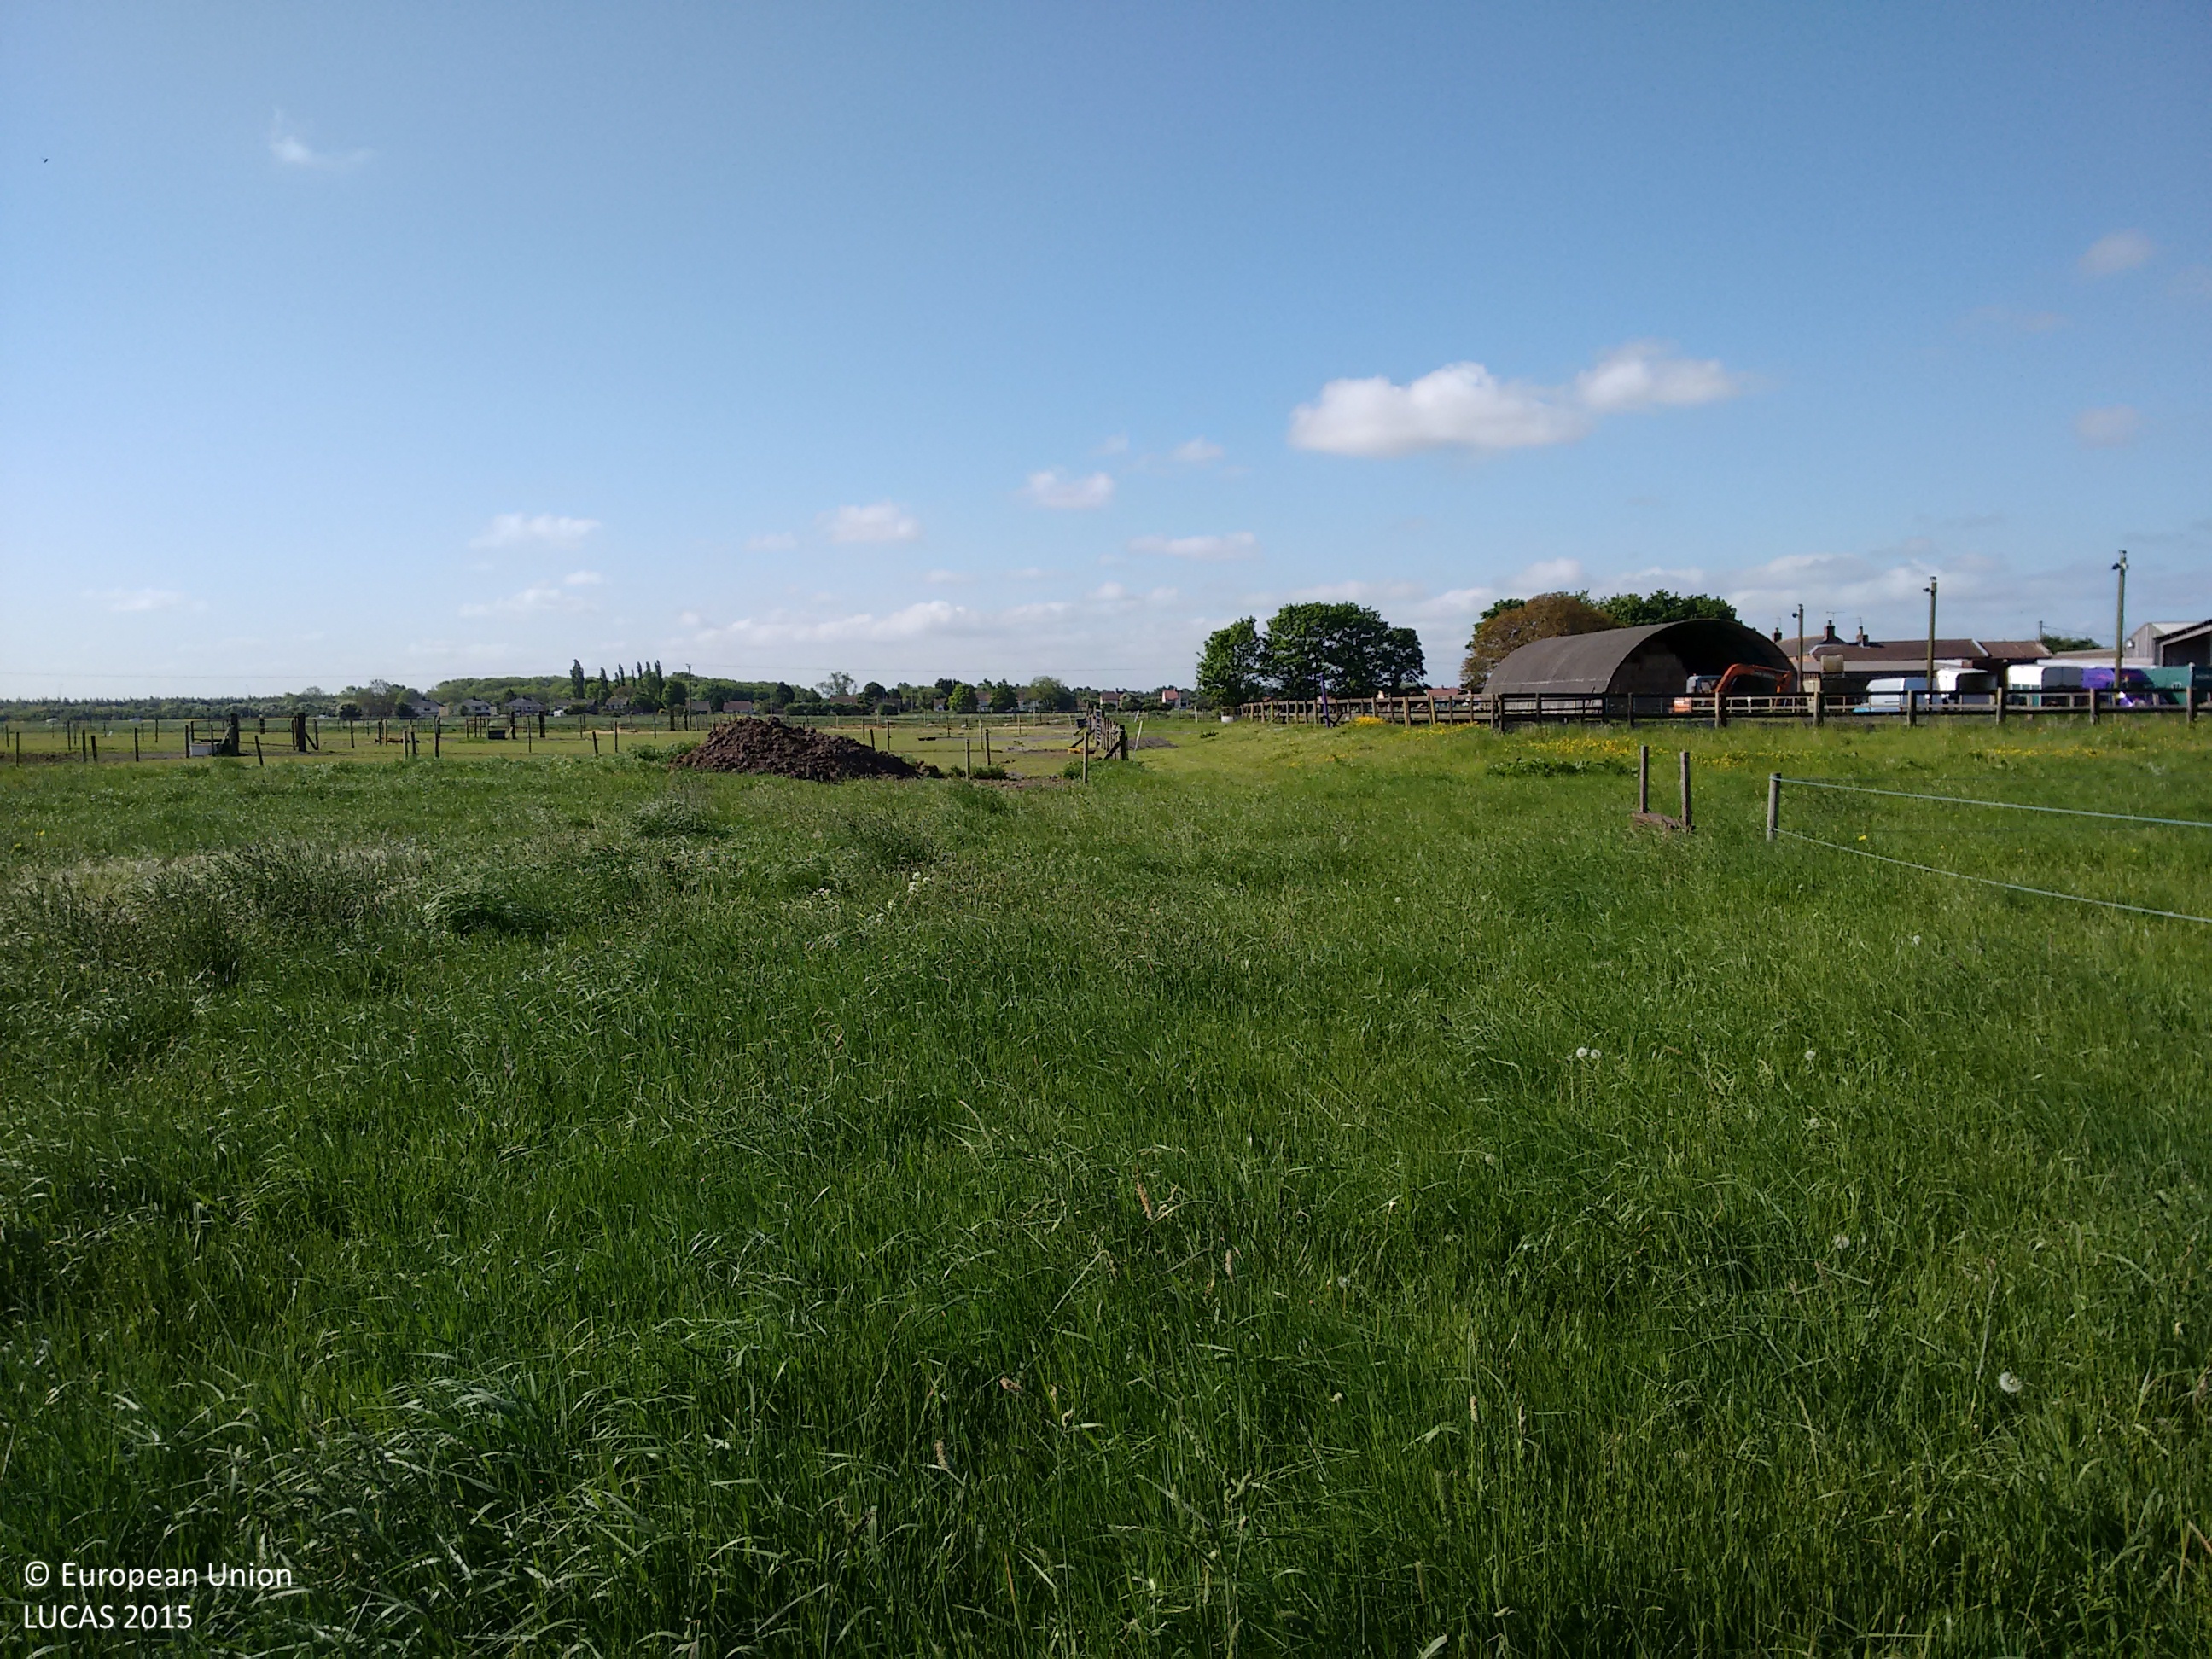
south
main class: Grassland
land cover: Grassland without tree/shrub cover
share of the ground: > 75 %
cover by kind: herbaceous plants 100 %
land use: Agriculture (excluding fallow land and kitchen gardens)
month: May
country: GB
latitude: 53.5957
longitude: -0.7222
